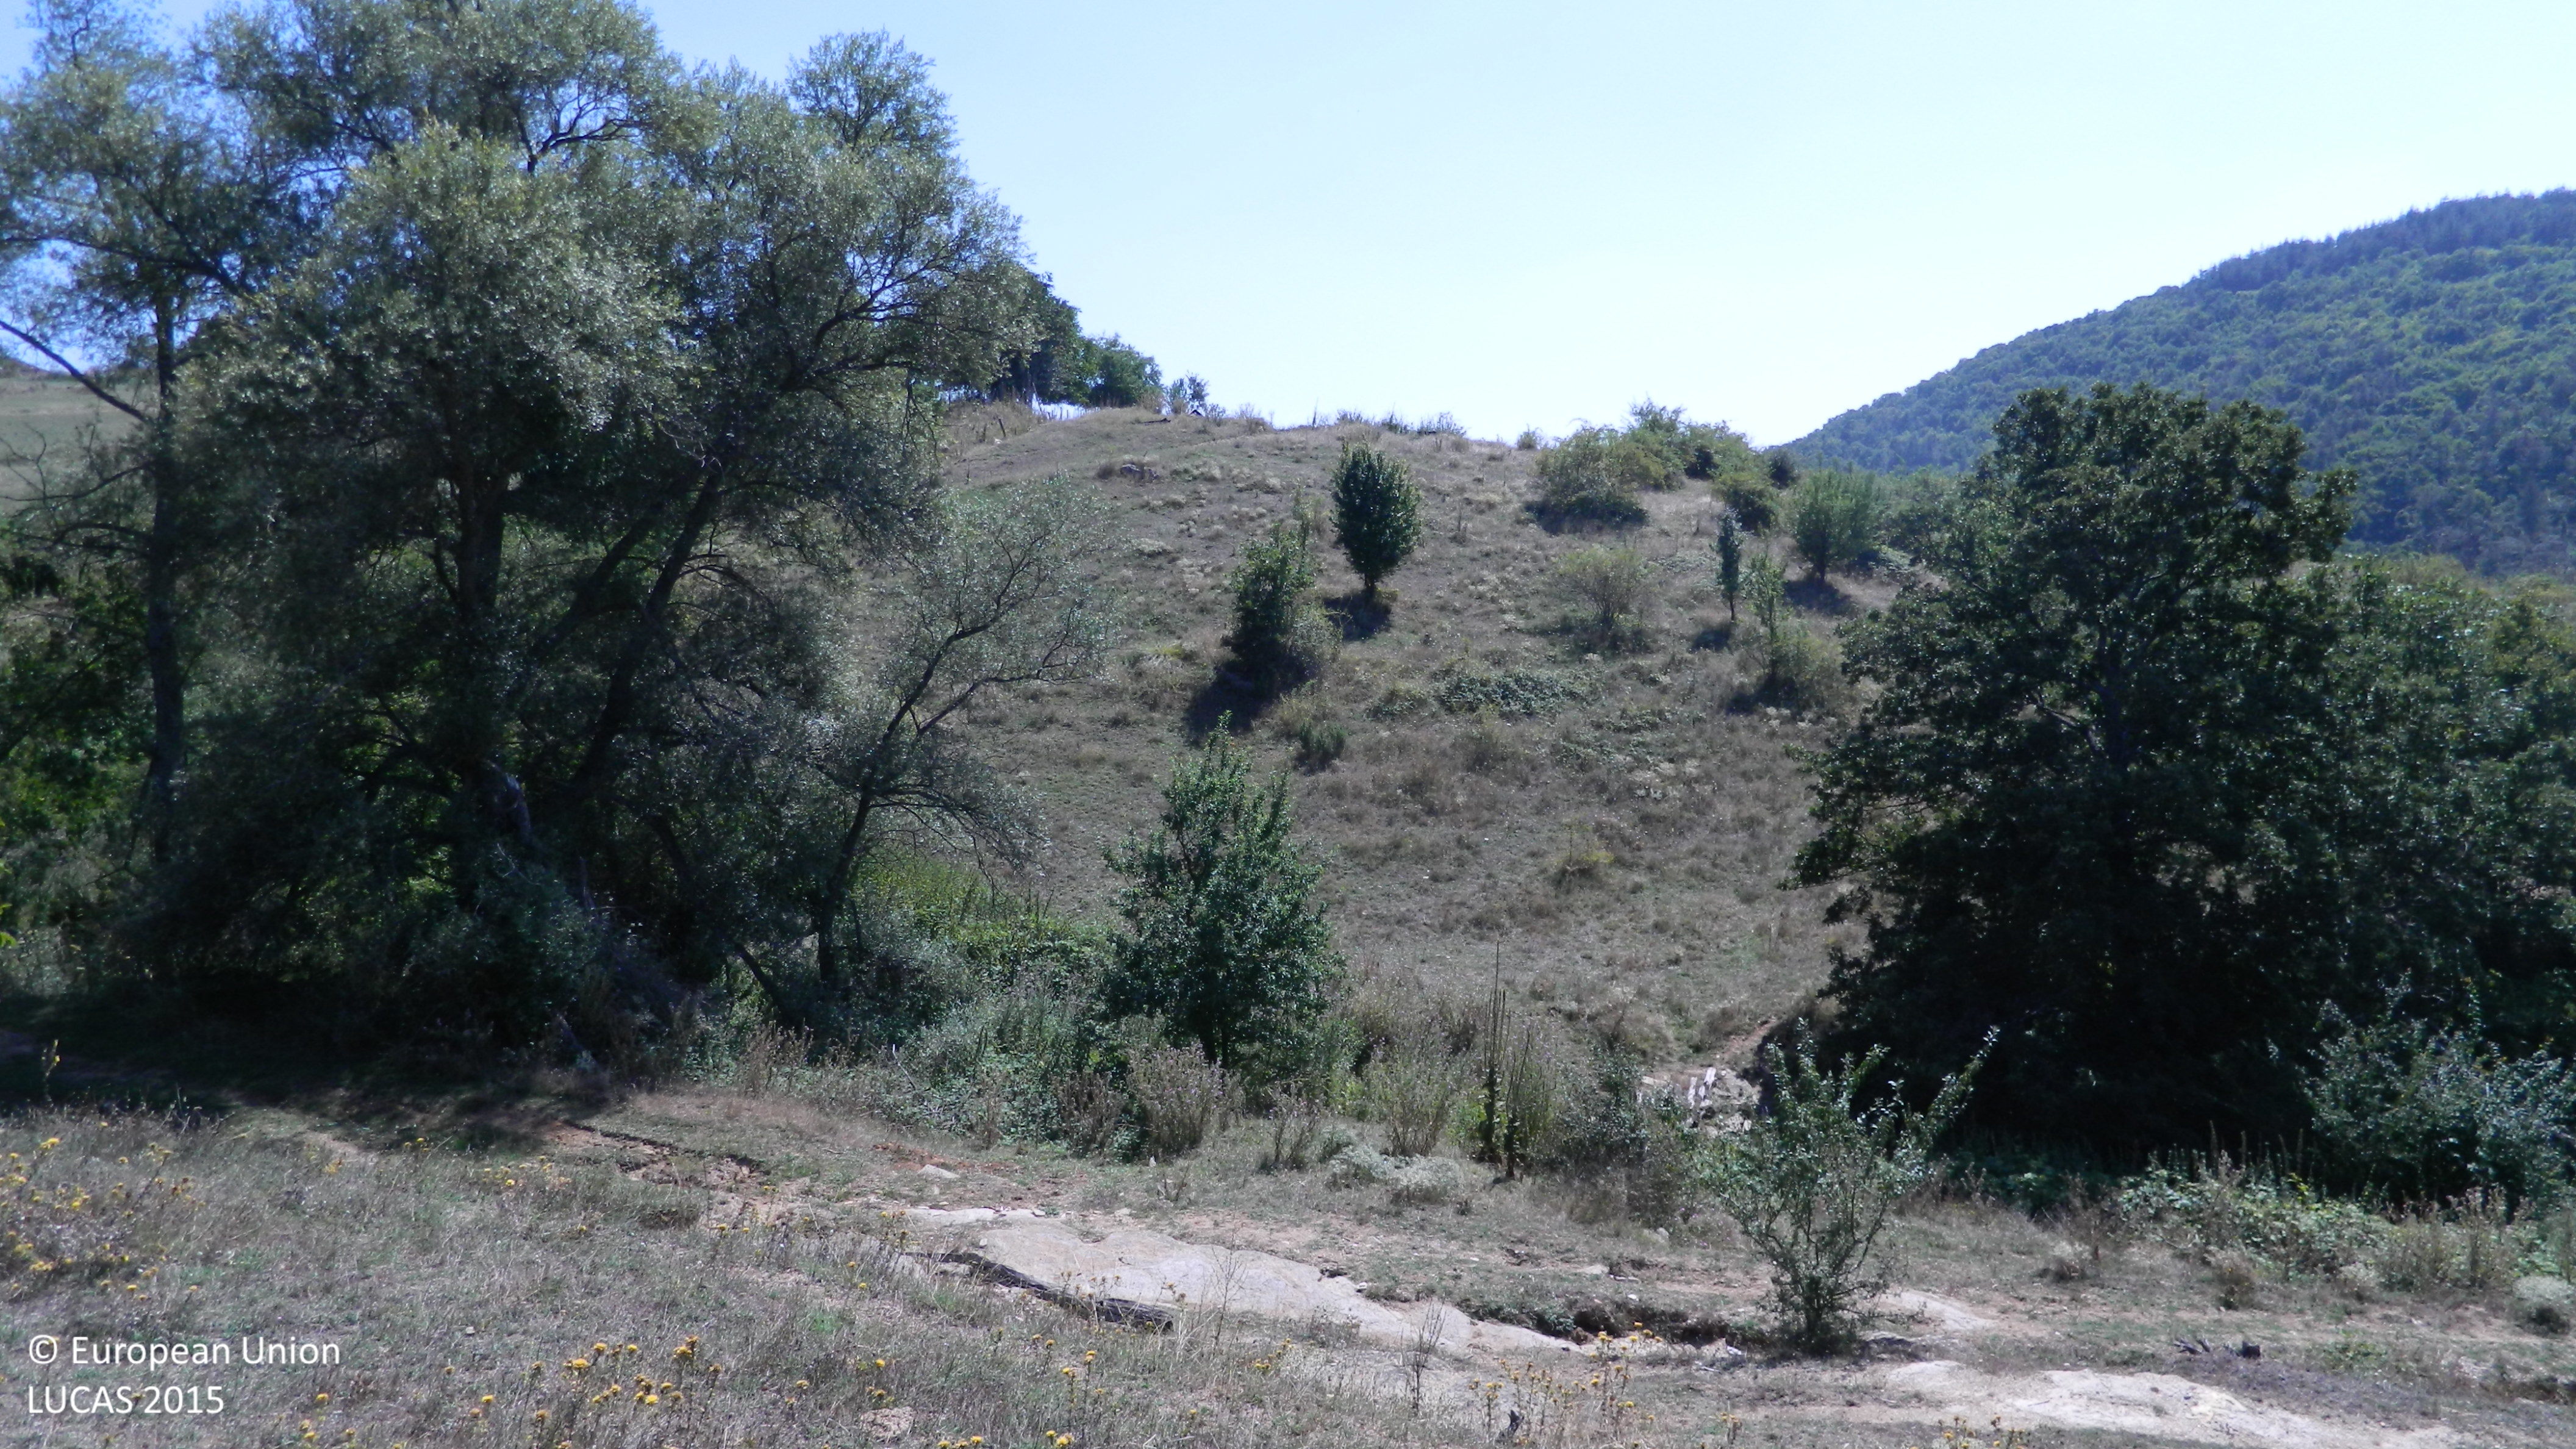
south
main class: Grassland
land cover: Grassland without tree/shrub cover
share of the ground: > 75 %
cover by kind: herbaceous plants 95 %, shrubs 5 %
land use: Agriculture (excluding fallow land and kitchen gardens)
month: August
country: BG
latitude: 41.5357
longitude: 25.8997
